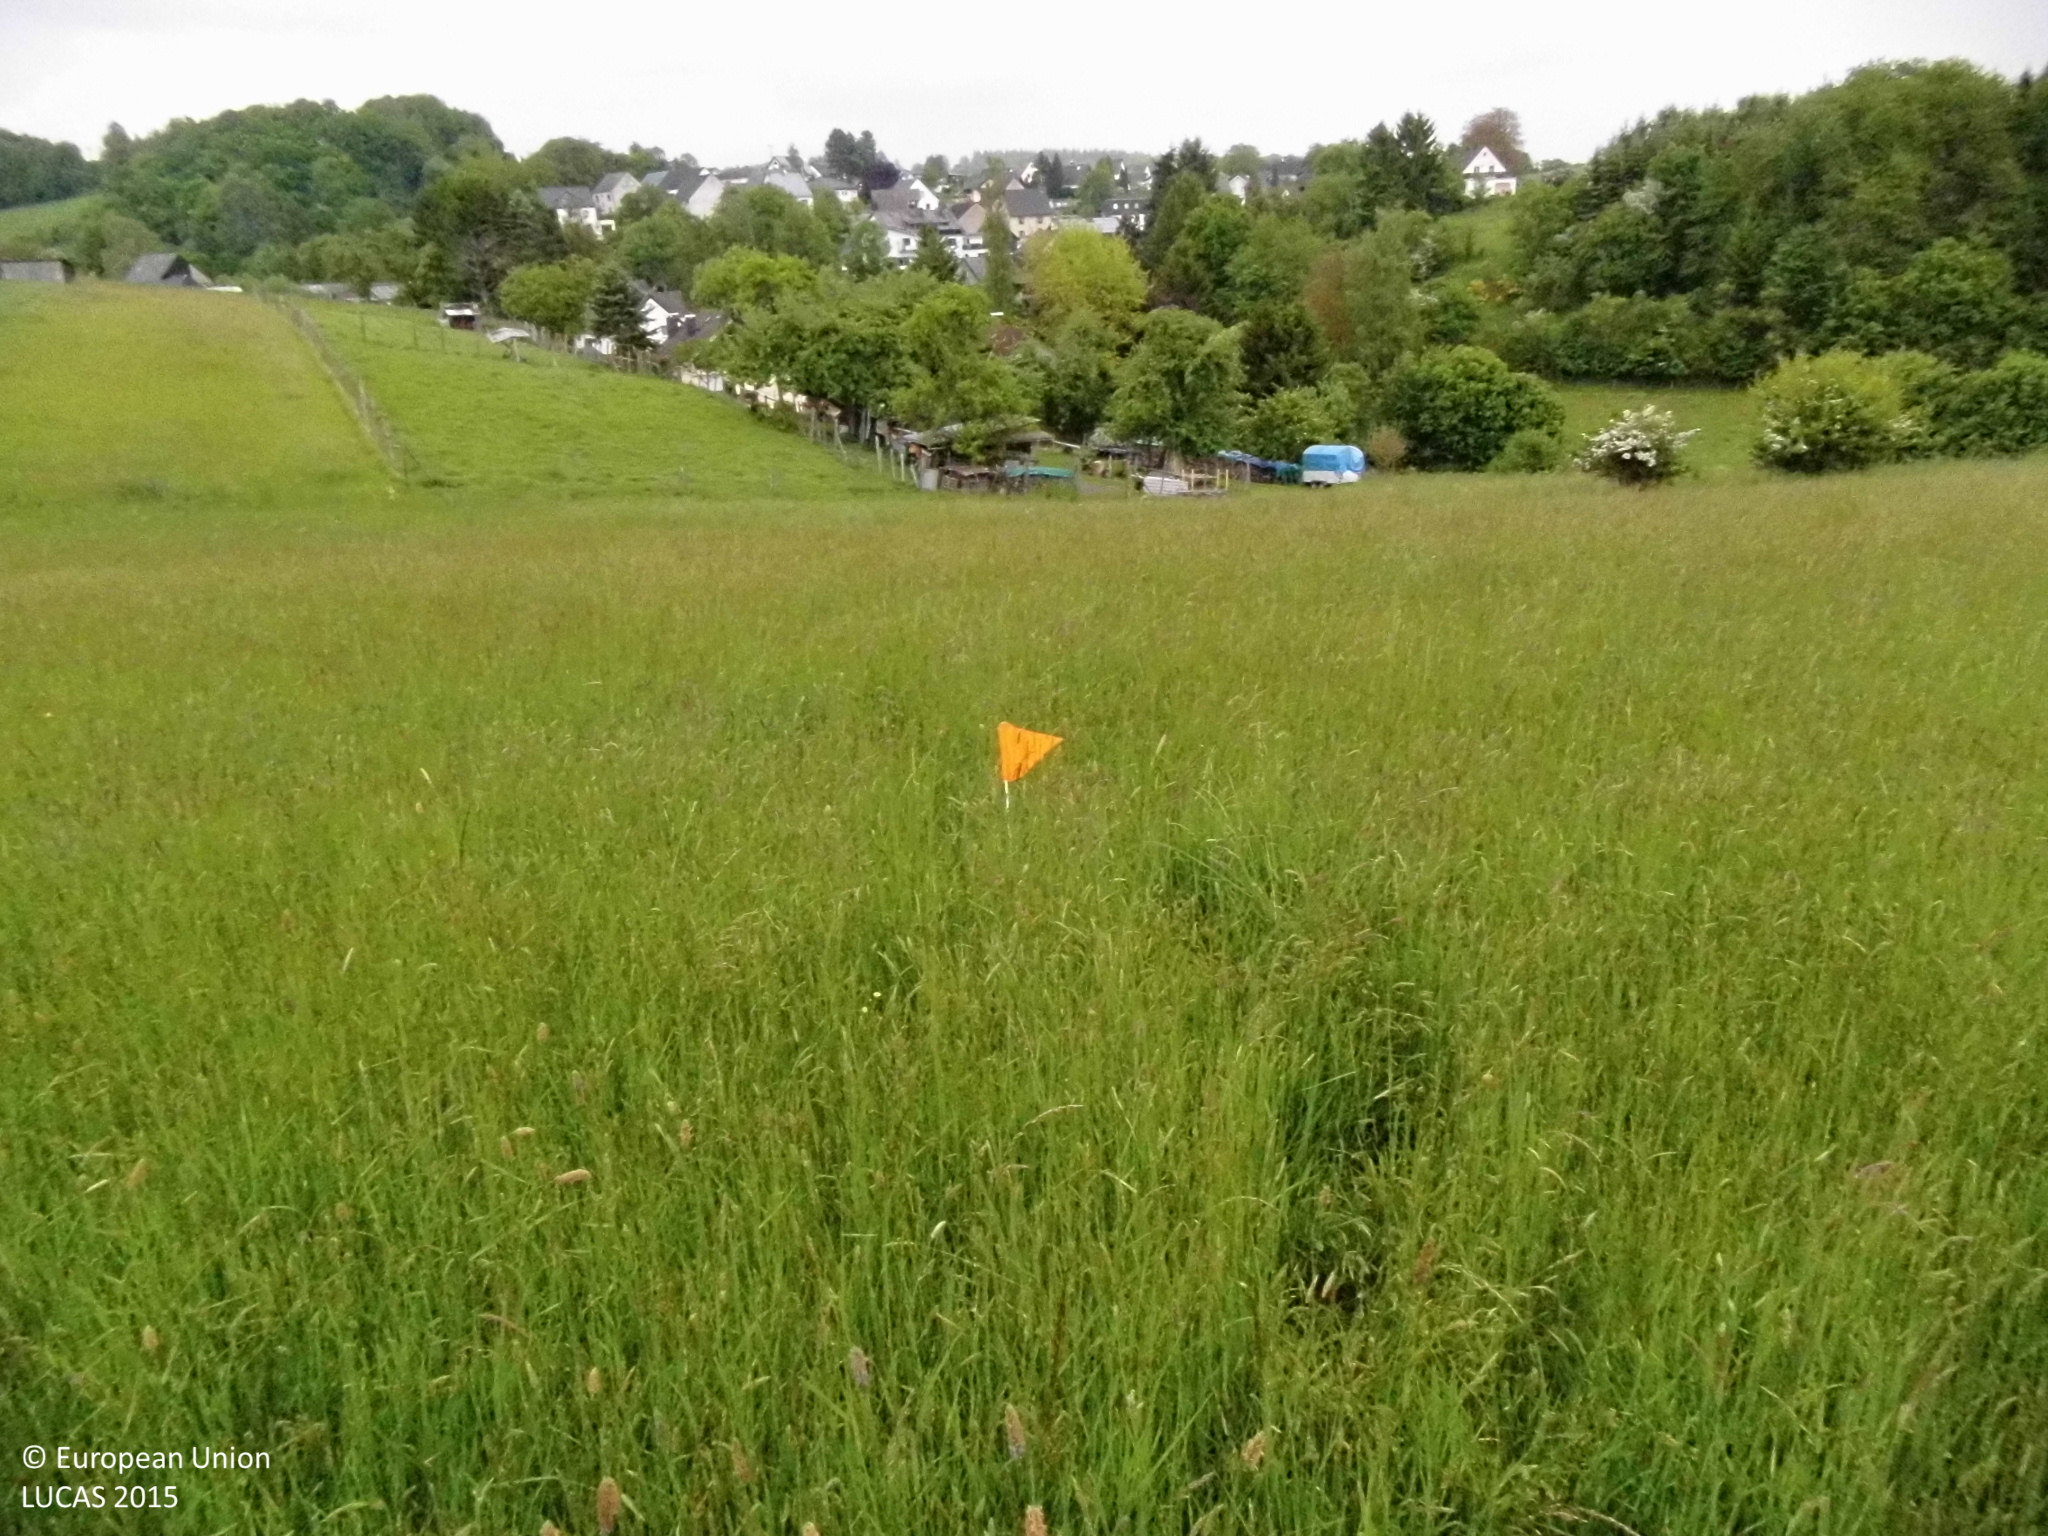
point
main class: Grassland
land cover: Grassland without tree/shrub cover
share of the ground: > 75 %
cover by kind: herbaceous plants 100 %
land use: Agriculture (excluding fallow land and kitchen gardens)
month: May
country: DE
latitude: 50.5353
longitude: 7.5312
